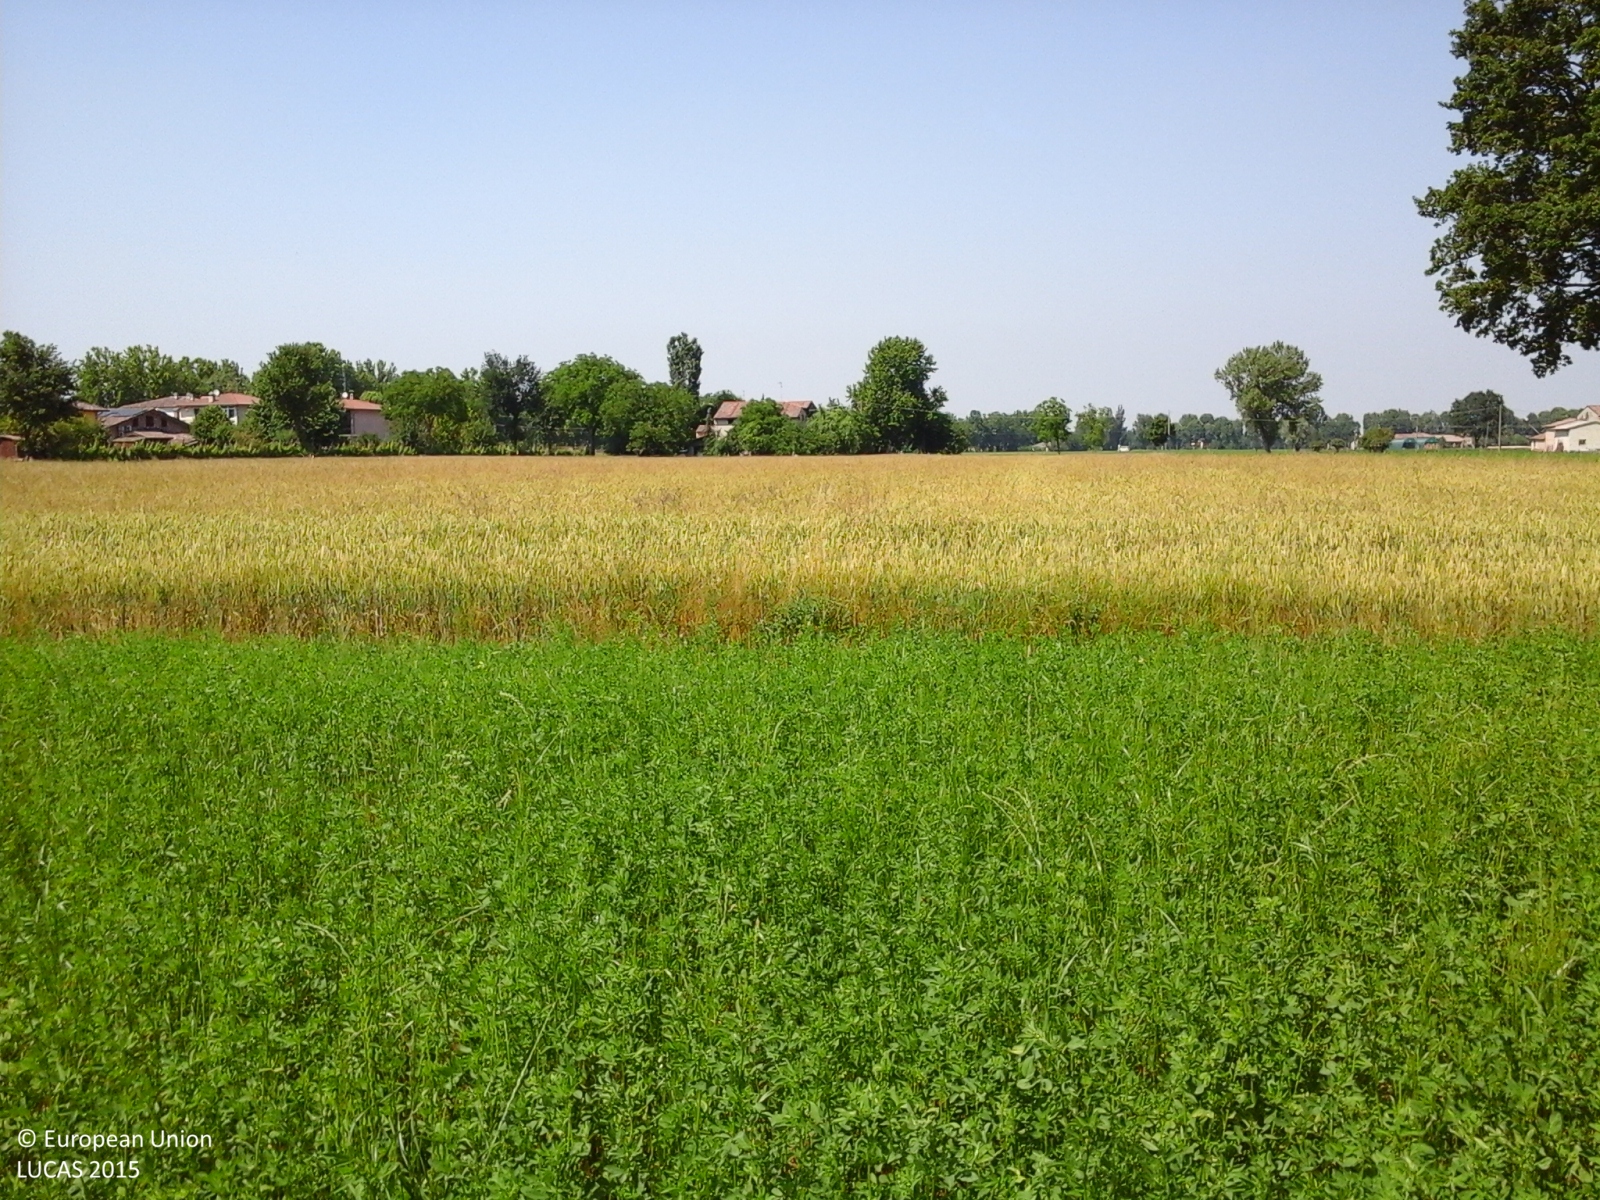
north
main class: Cropland
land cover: Lucerne
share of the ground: > 75 %
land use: Agriculture (excluding fallow land and kitchen gardens)
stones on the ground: < 10 %
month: May
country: IT
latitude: 44.9093
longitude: 10.2149
